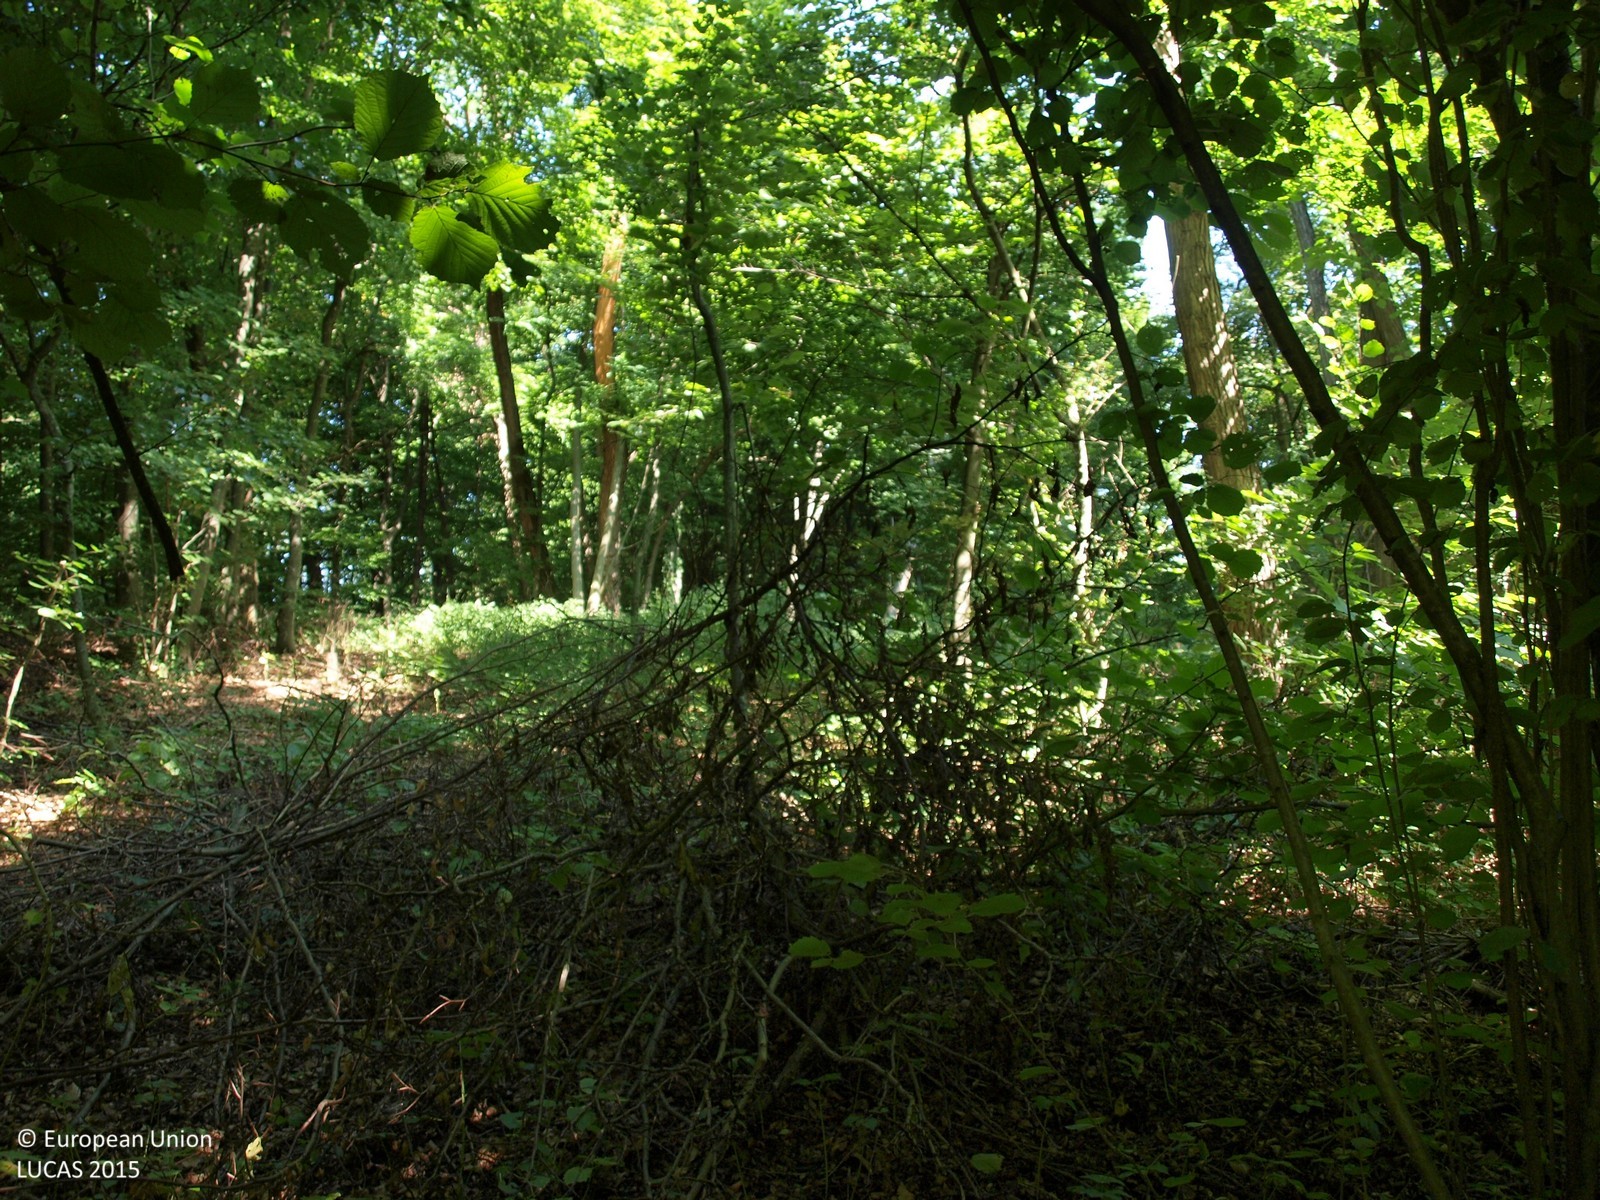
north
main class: Woodland
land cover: Broadleaved woodland
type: beech forest
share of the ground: > 75 %
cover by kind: broadleaved forest trees 100 %
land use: Forestry
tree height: > 5 m
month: August
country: HR
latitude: 46.1020
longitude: 16.4550
